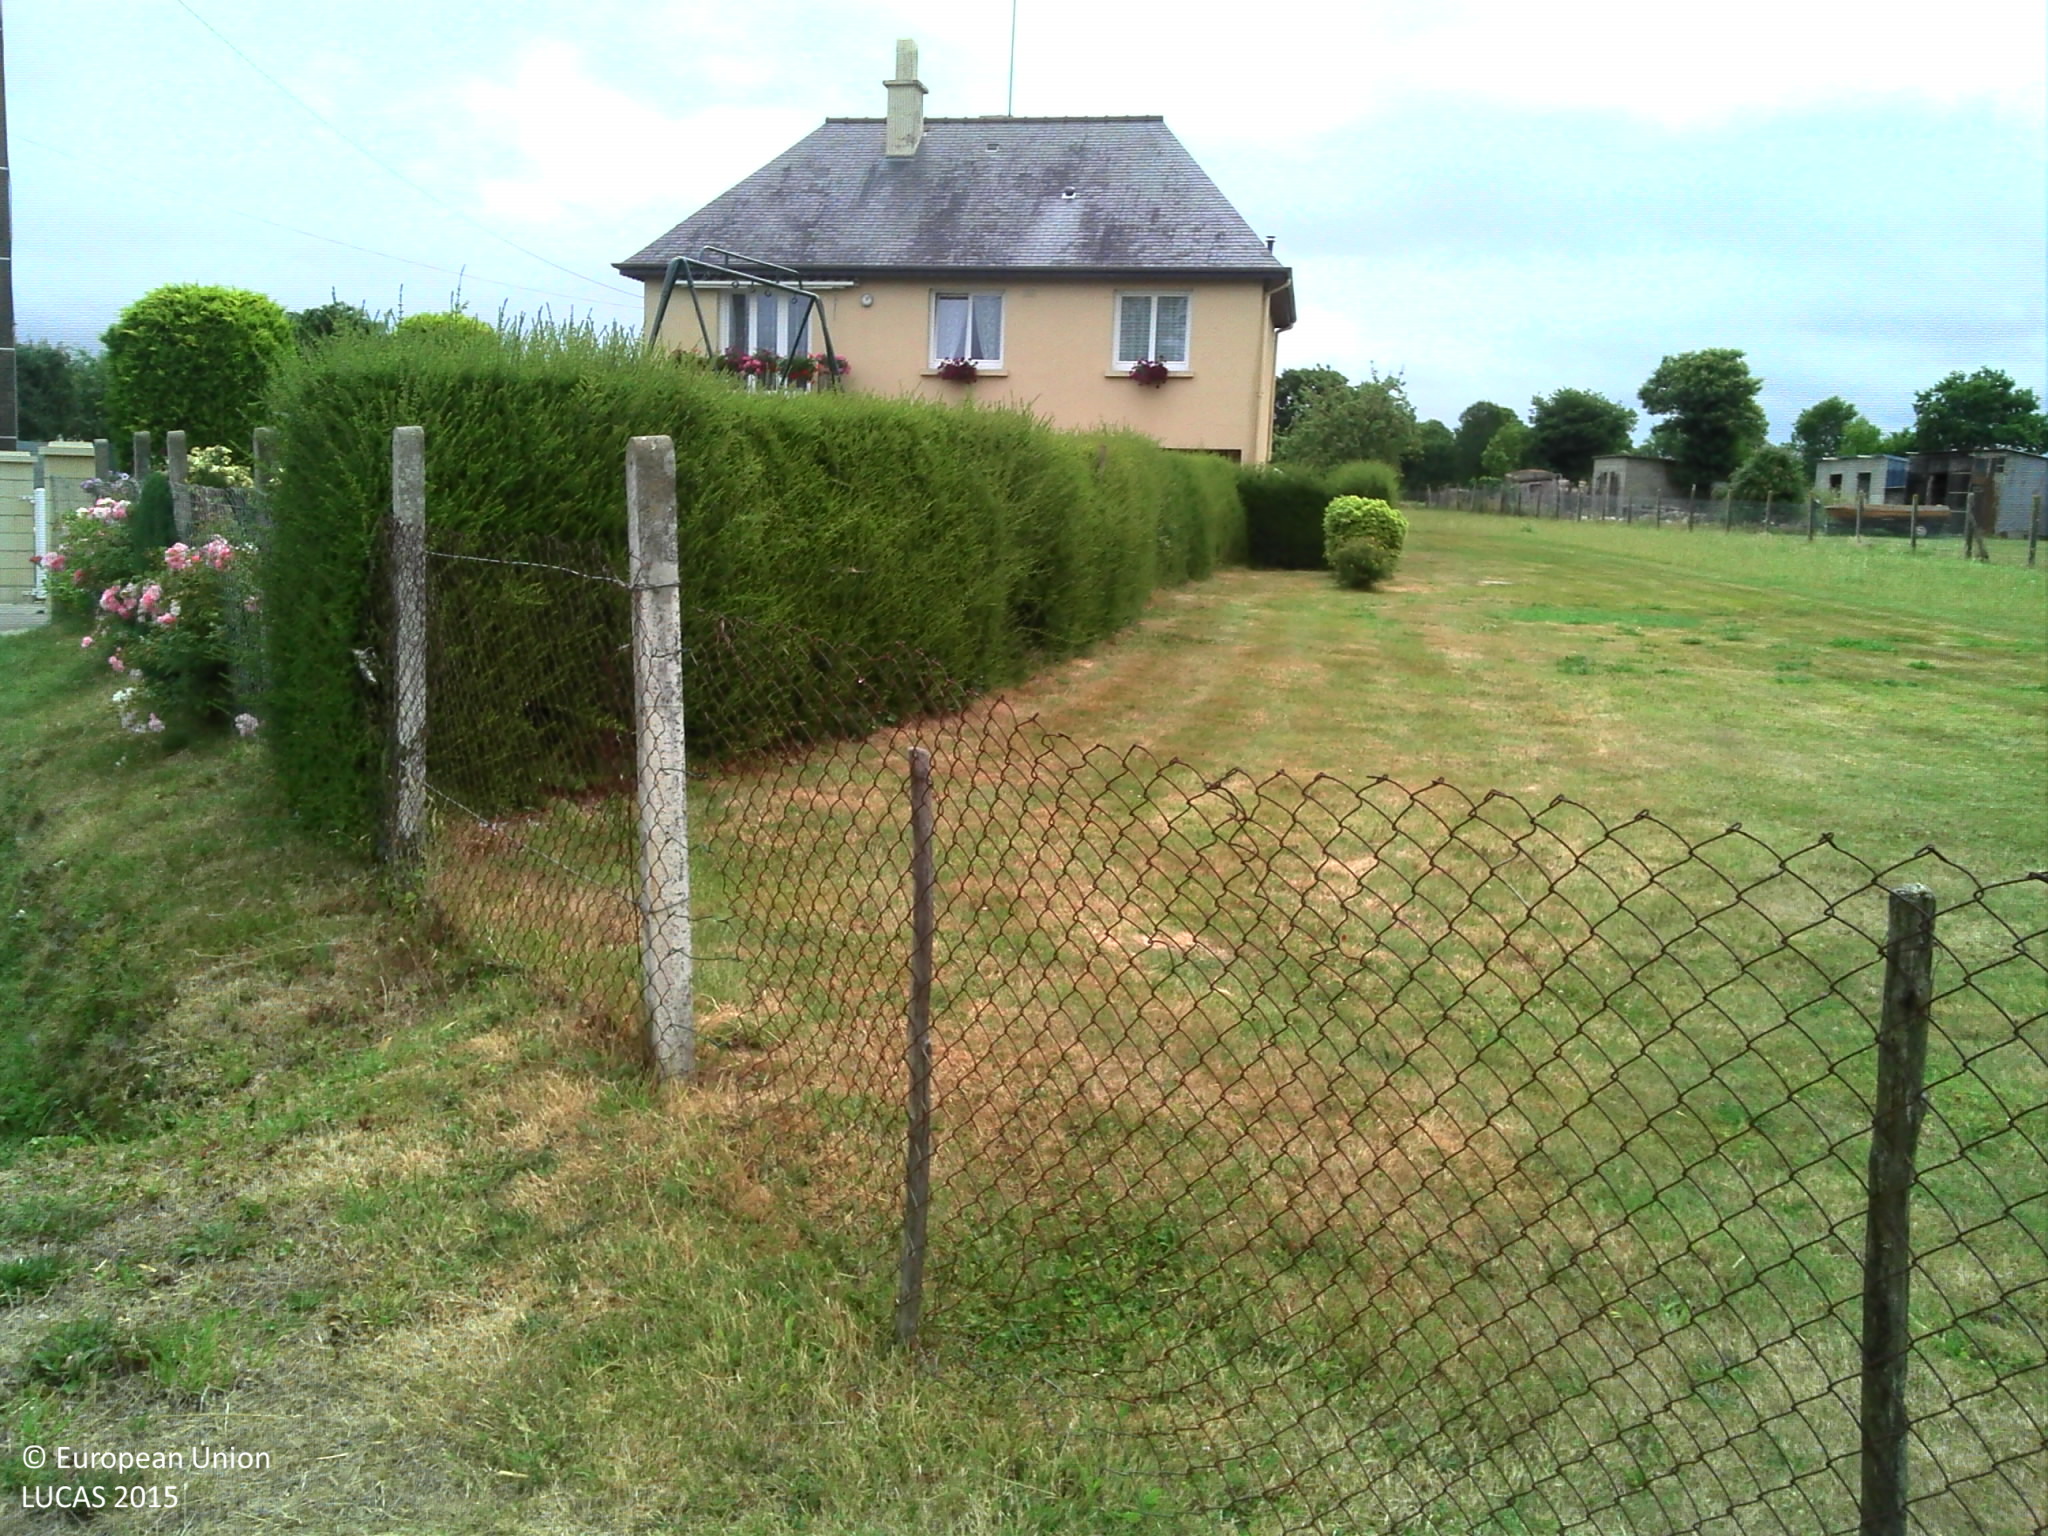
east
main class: Grassland
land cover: Grassland without tree/shrub cover
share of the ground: > 75 %
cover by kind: herbaceous plants 100 %
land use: Residential
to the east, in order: Grassland without tree/shrub cover; Artificial constructions in urban areas; Maize; Broadleaved woodland; Fences; Grassland without tree/shrub cover; Lines of trees; Grassland without tree/shrub cover
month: July
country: FR
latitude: 47.7709
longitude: -1.6147
